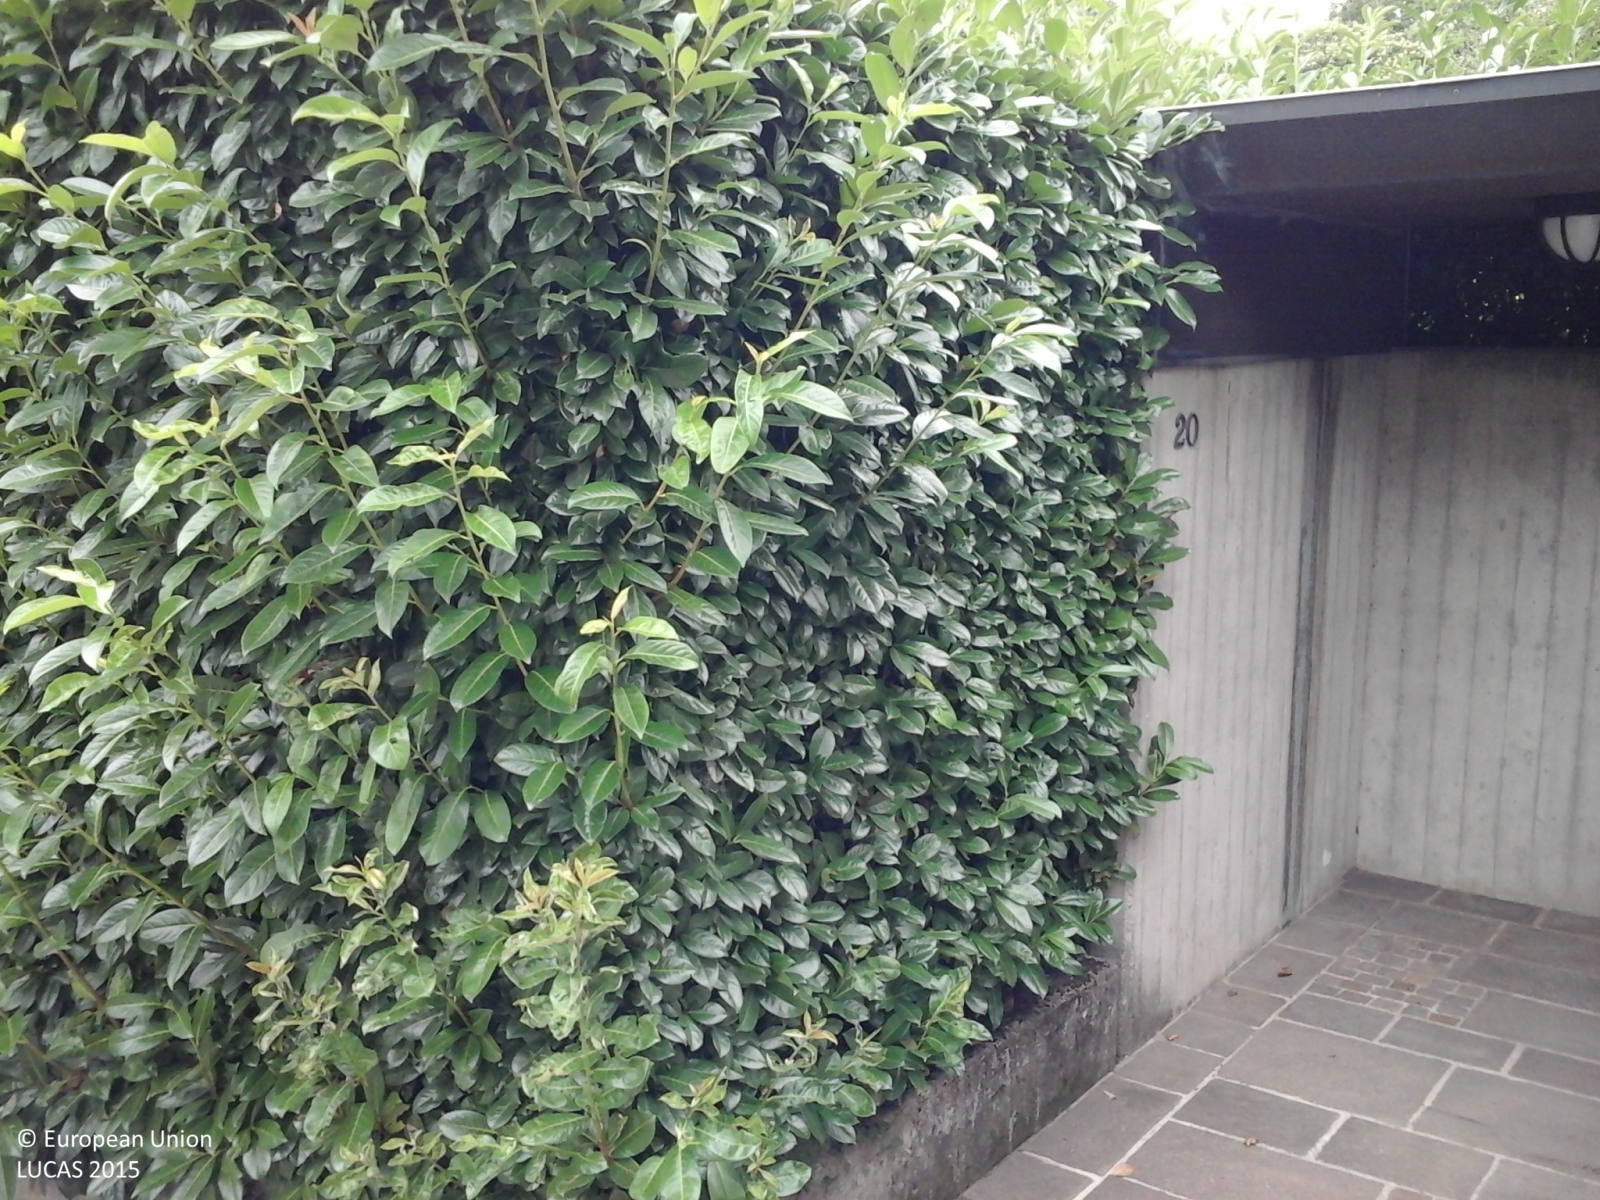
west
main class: Grassland
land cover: Grassland with sparse tree/shrub cover
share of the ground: > 75 %
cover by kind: herbaceous plants 85 %, shrubs 10 %, broadleaved forest trees 5 %
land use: Residential
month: August
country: IT
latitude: 45.7530
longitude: 9.1144
